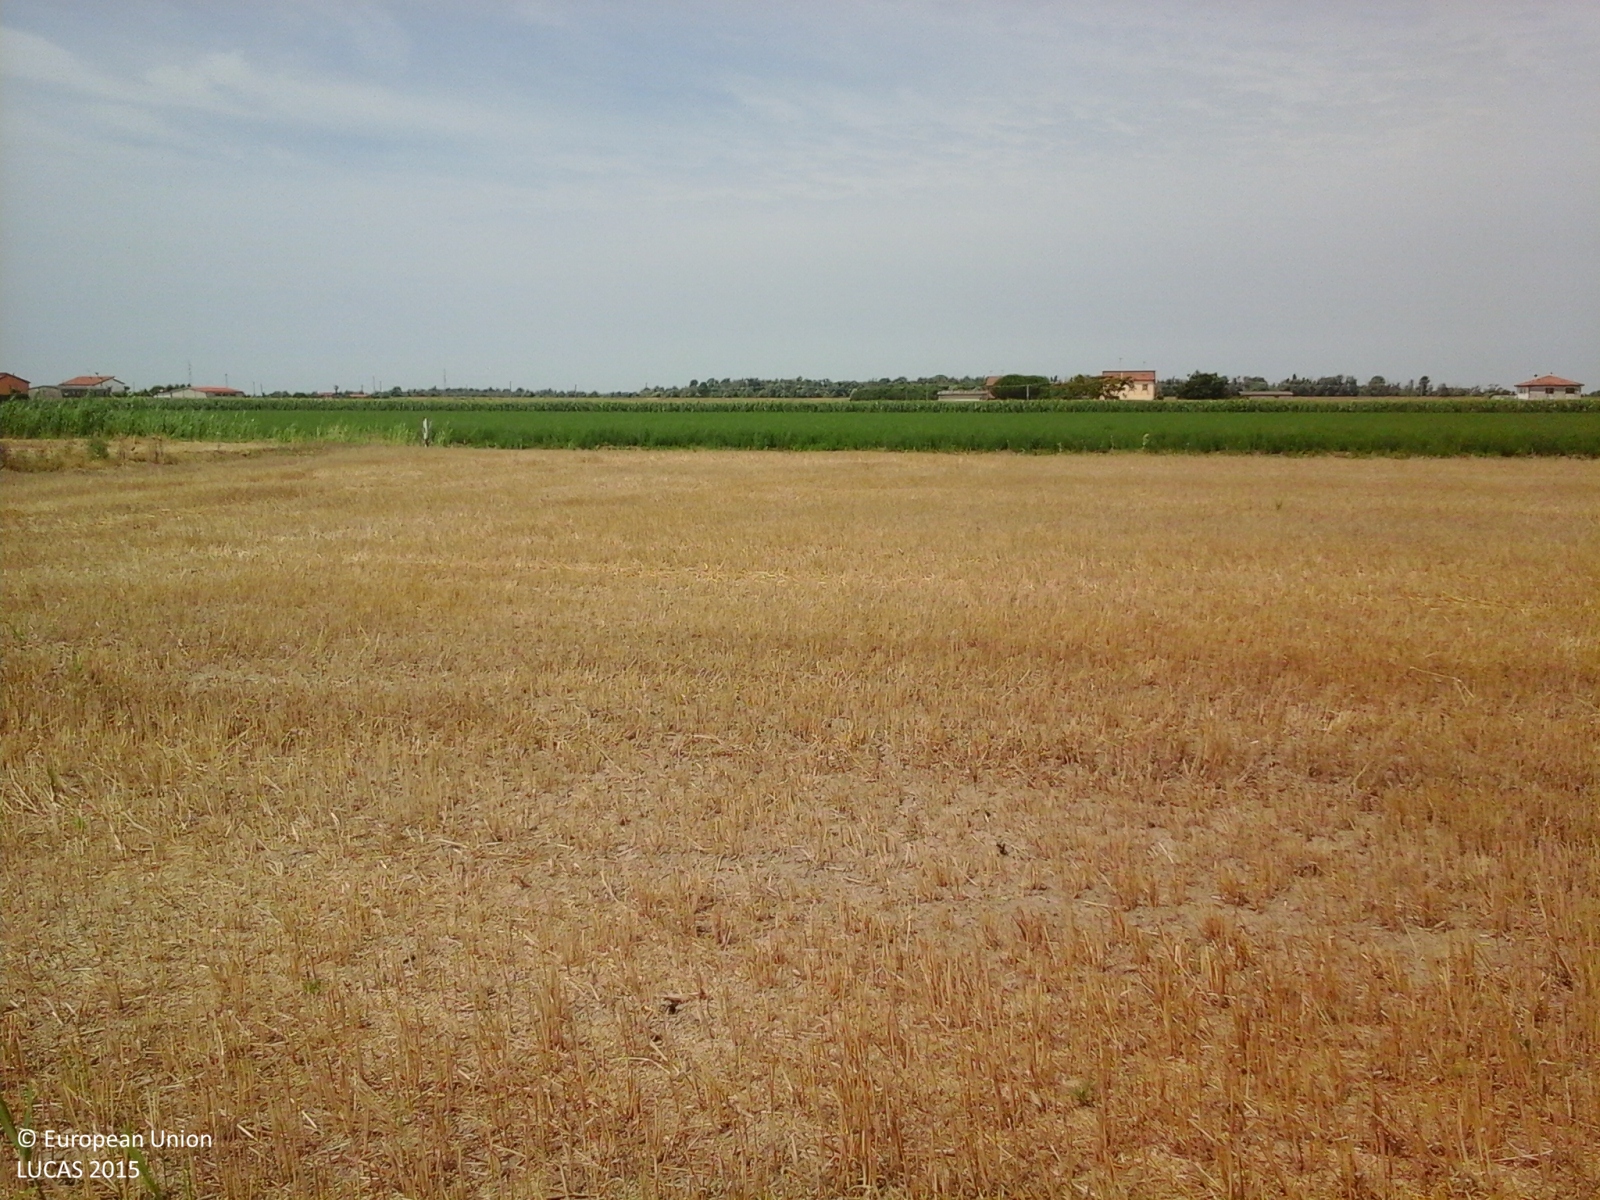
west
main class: Cropland
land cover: Common wheat
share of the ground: > 75 %
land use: Agriculture (excluding fallow land and kitchen gardens)
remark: Harvested field
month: June
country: IT
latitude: 44.9526
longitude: 12.4673
